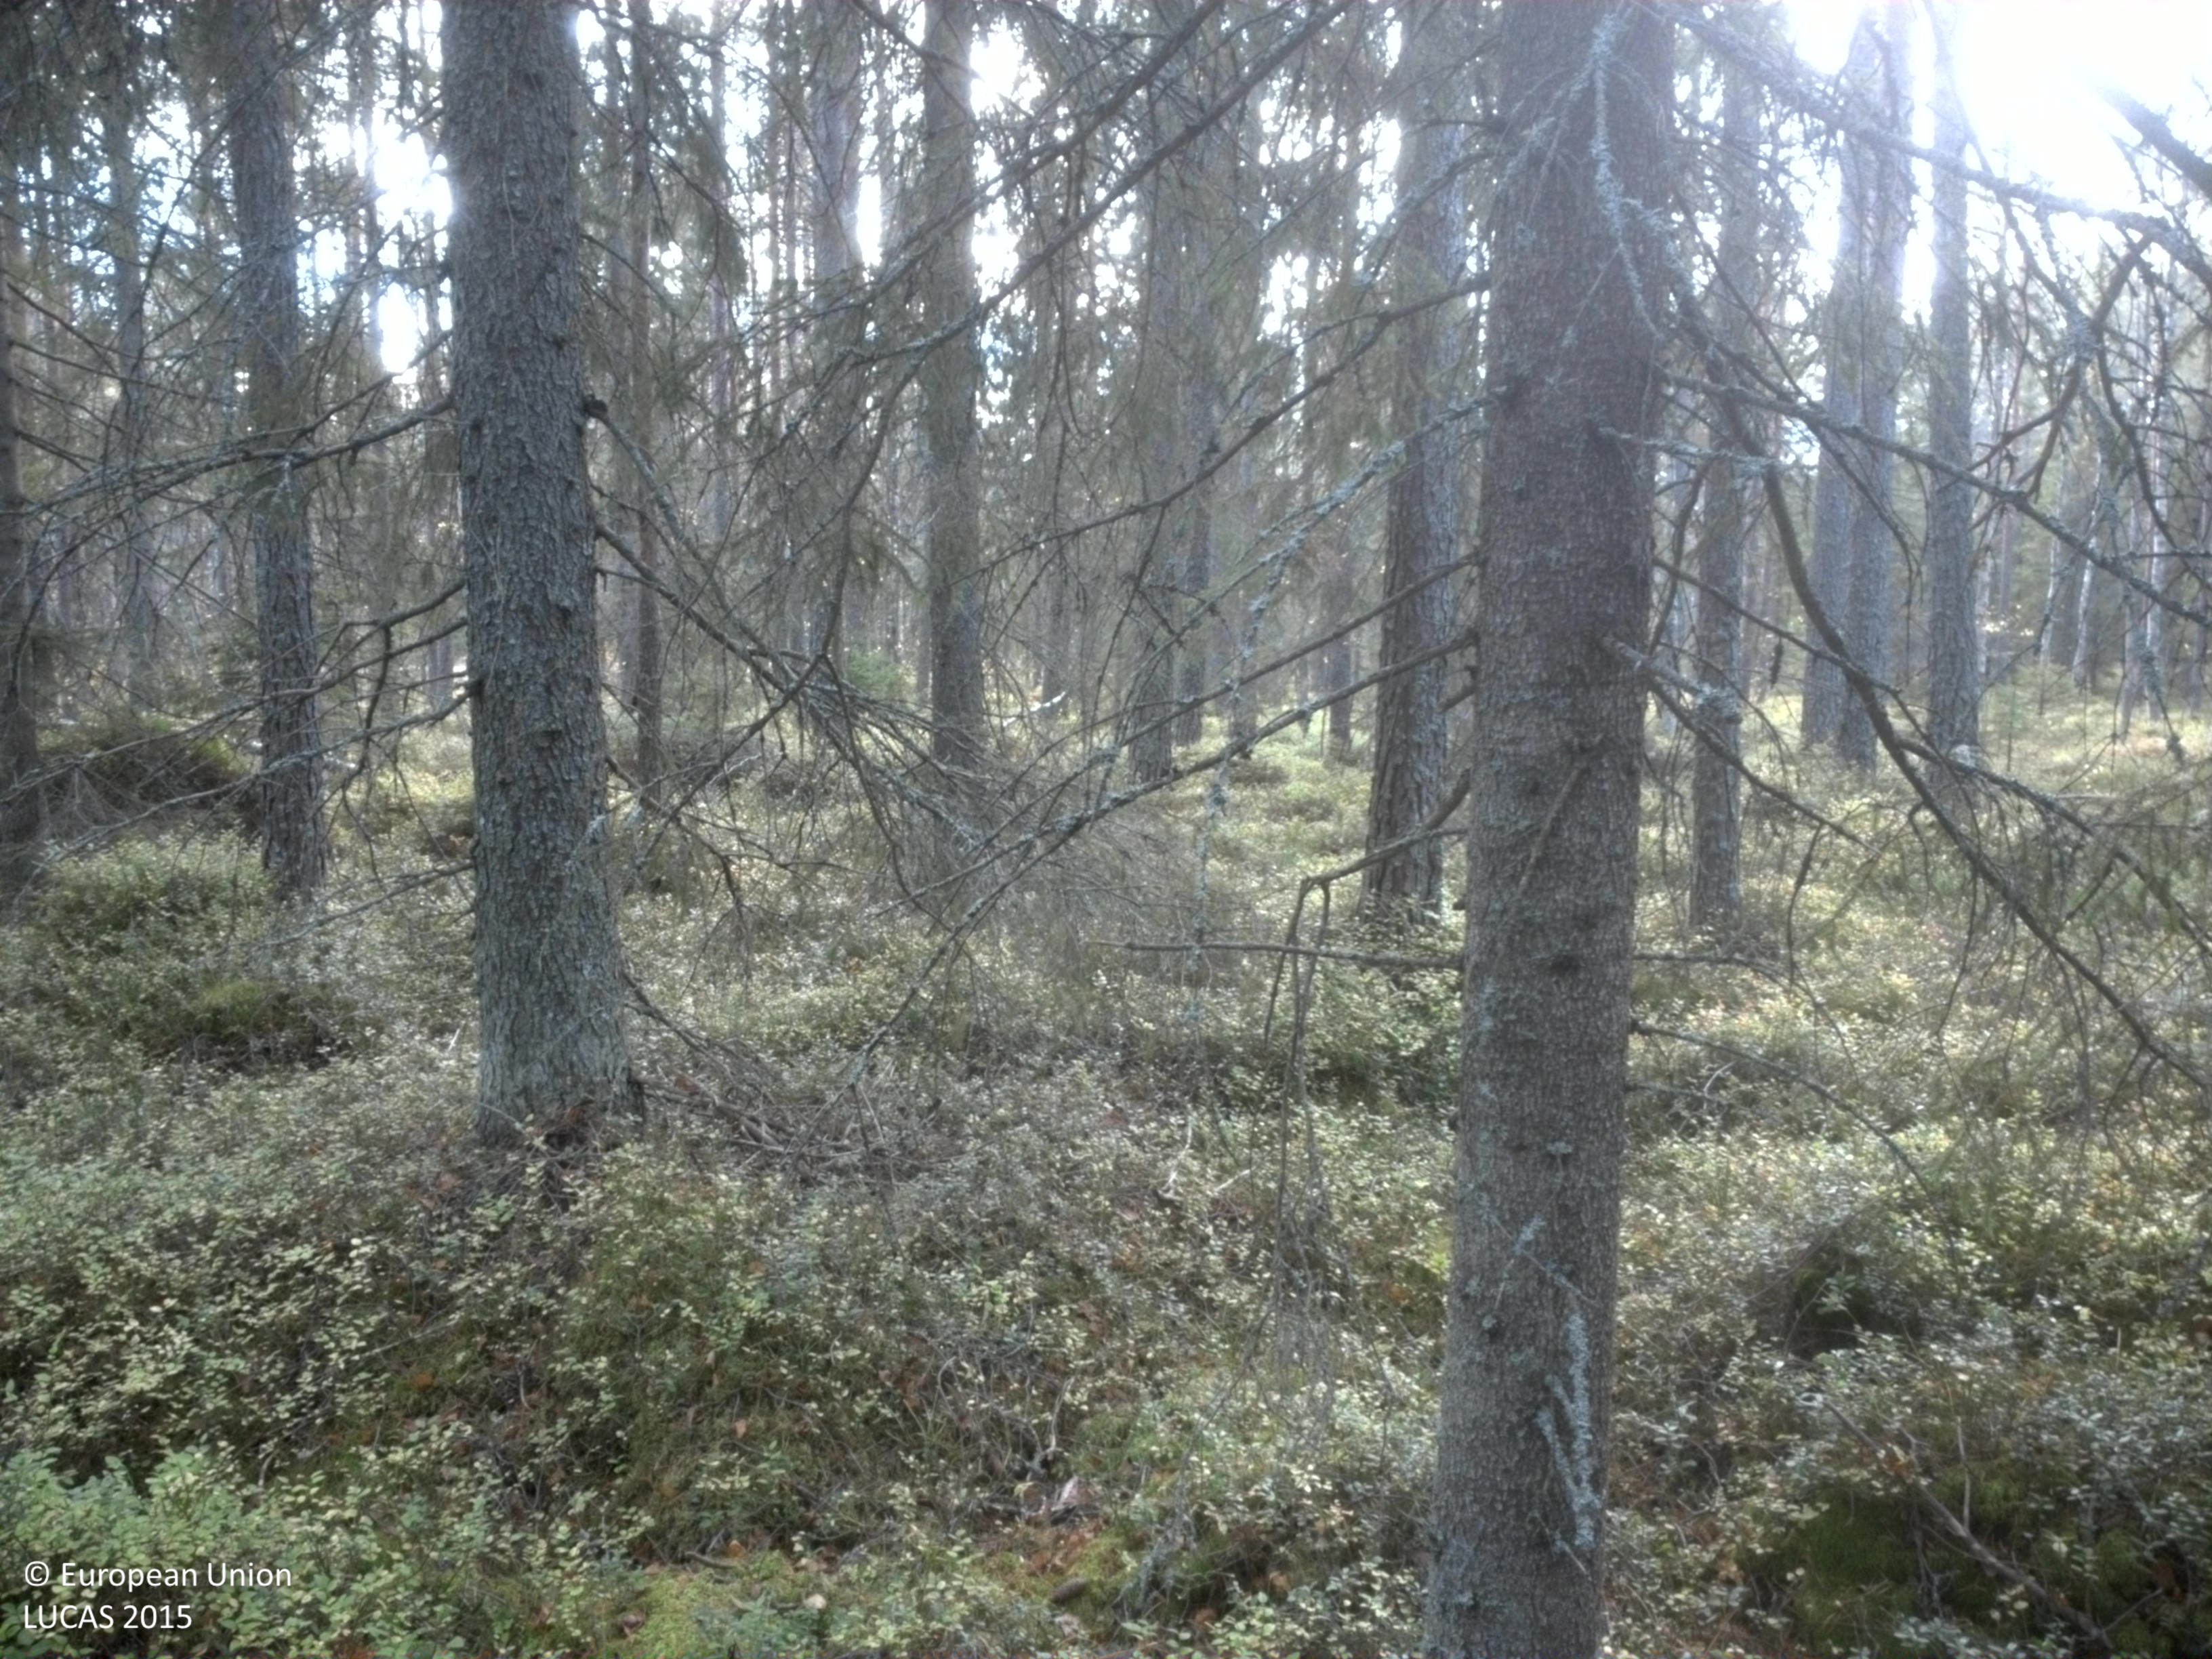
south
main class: Woodland
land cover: Other mixed woodland
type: boreal forest
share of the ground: 50 - 75 %
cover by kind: coniferous forest trees 45 %, shrubs 35 %, broadleaved forest trees 20 %
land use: Forestry
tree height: > 5 m
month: October
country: SE
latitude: 63.9953
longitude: 20.7570
